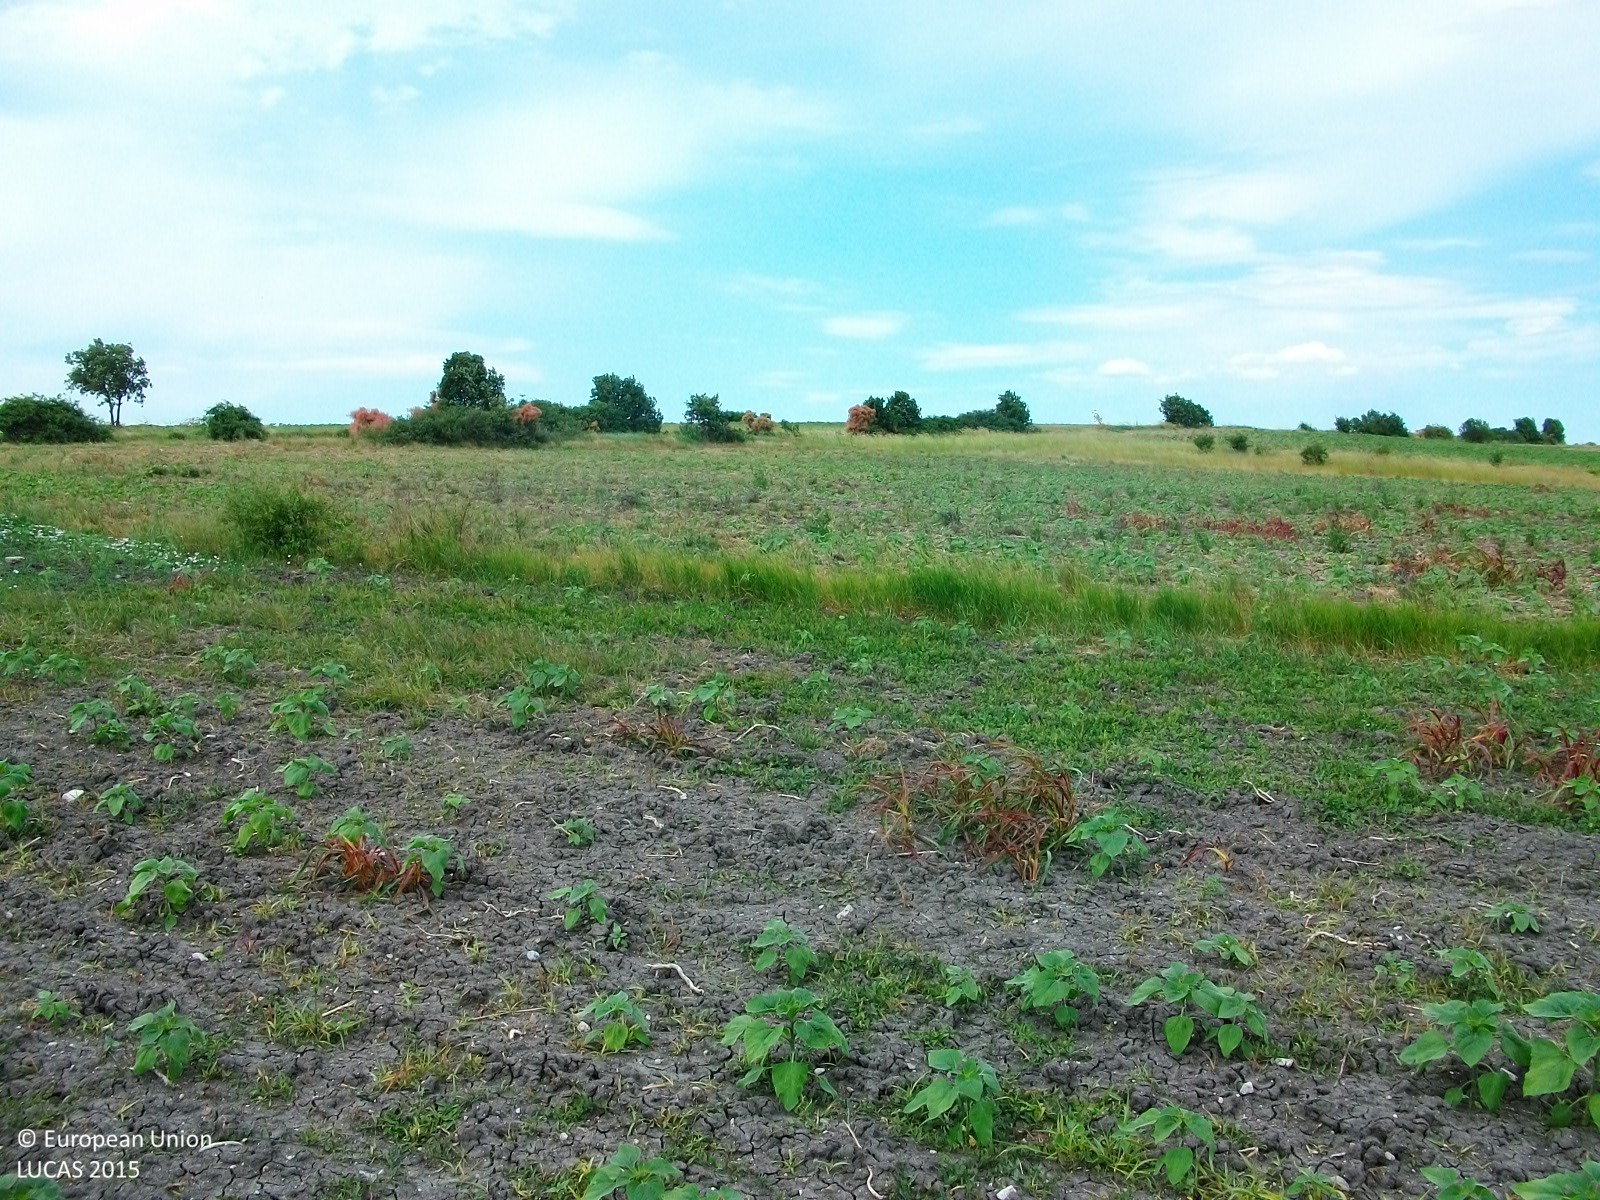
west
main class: Cropland
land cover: Sunflower
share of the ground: < 10 %
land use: Agriculture (excluding fallow land and kitchen gardens)
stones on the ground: < 10 %
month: June
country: GR
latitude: 41.6913
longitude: 26.1864
